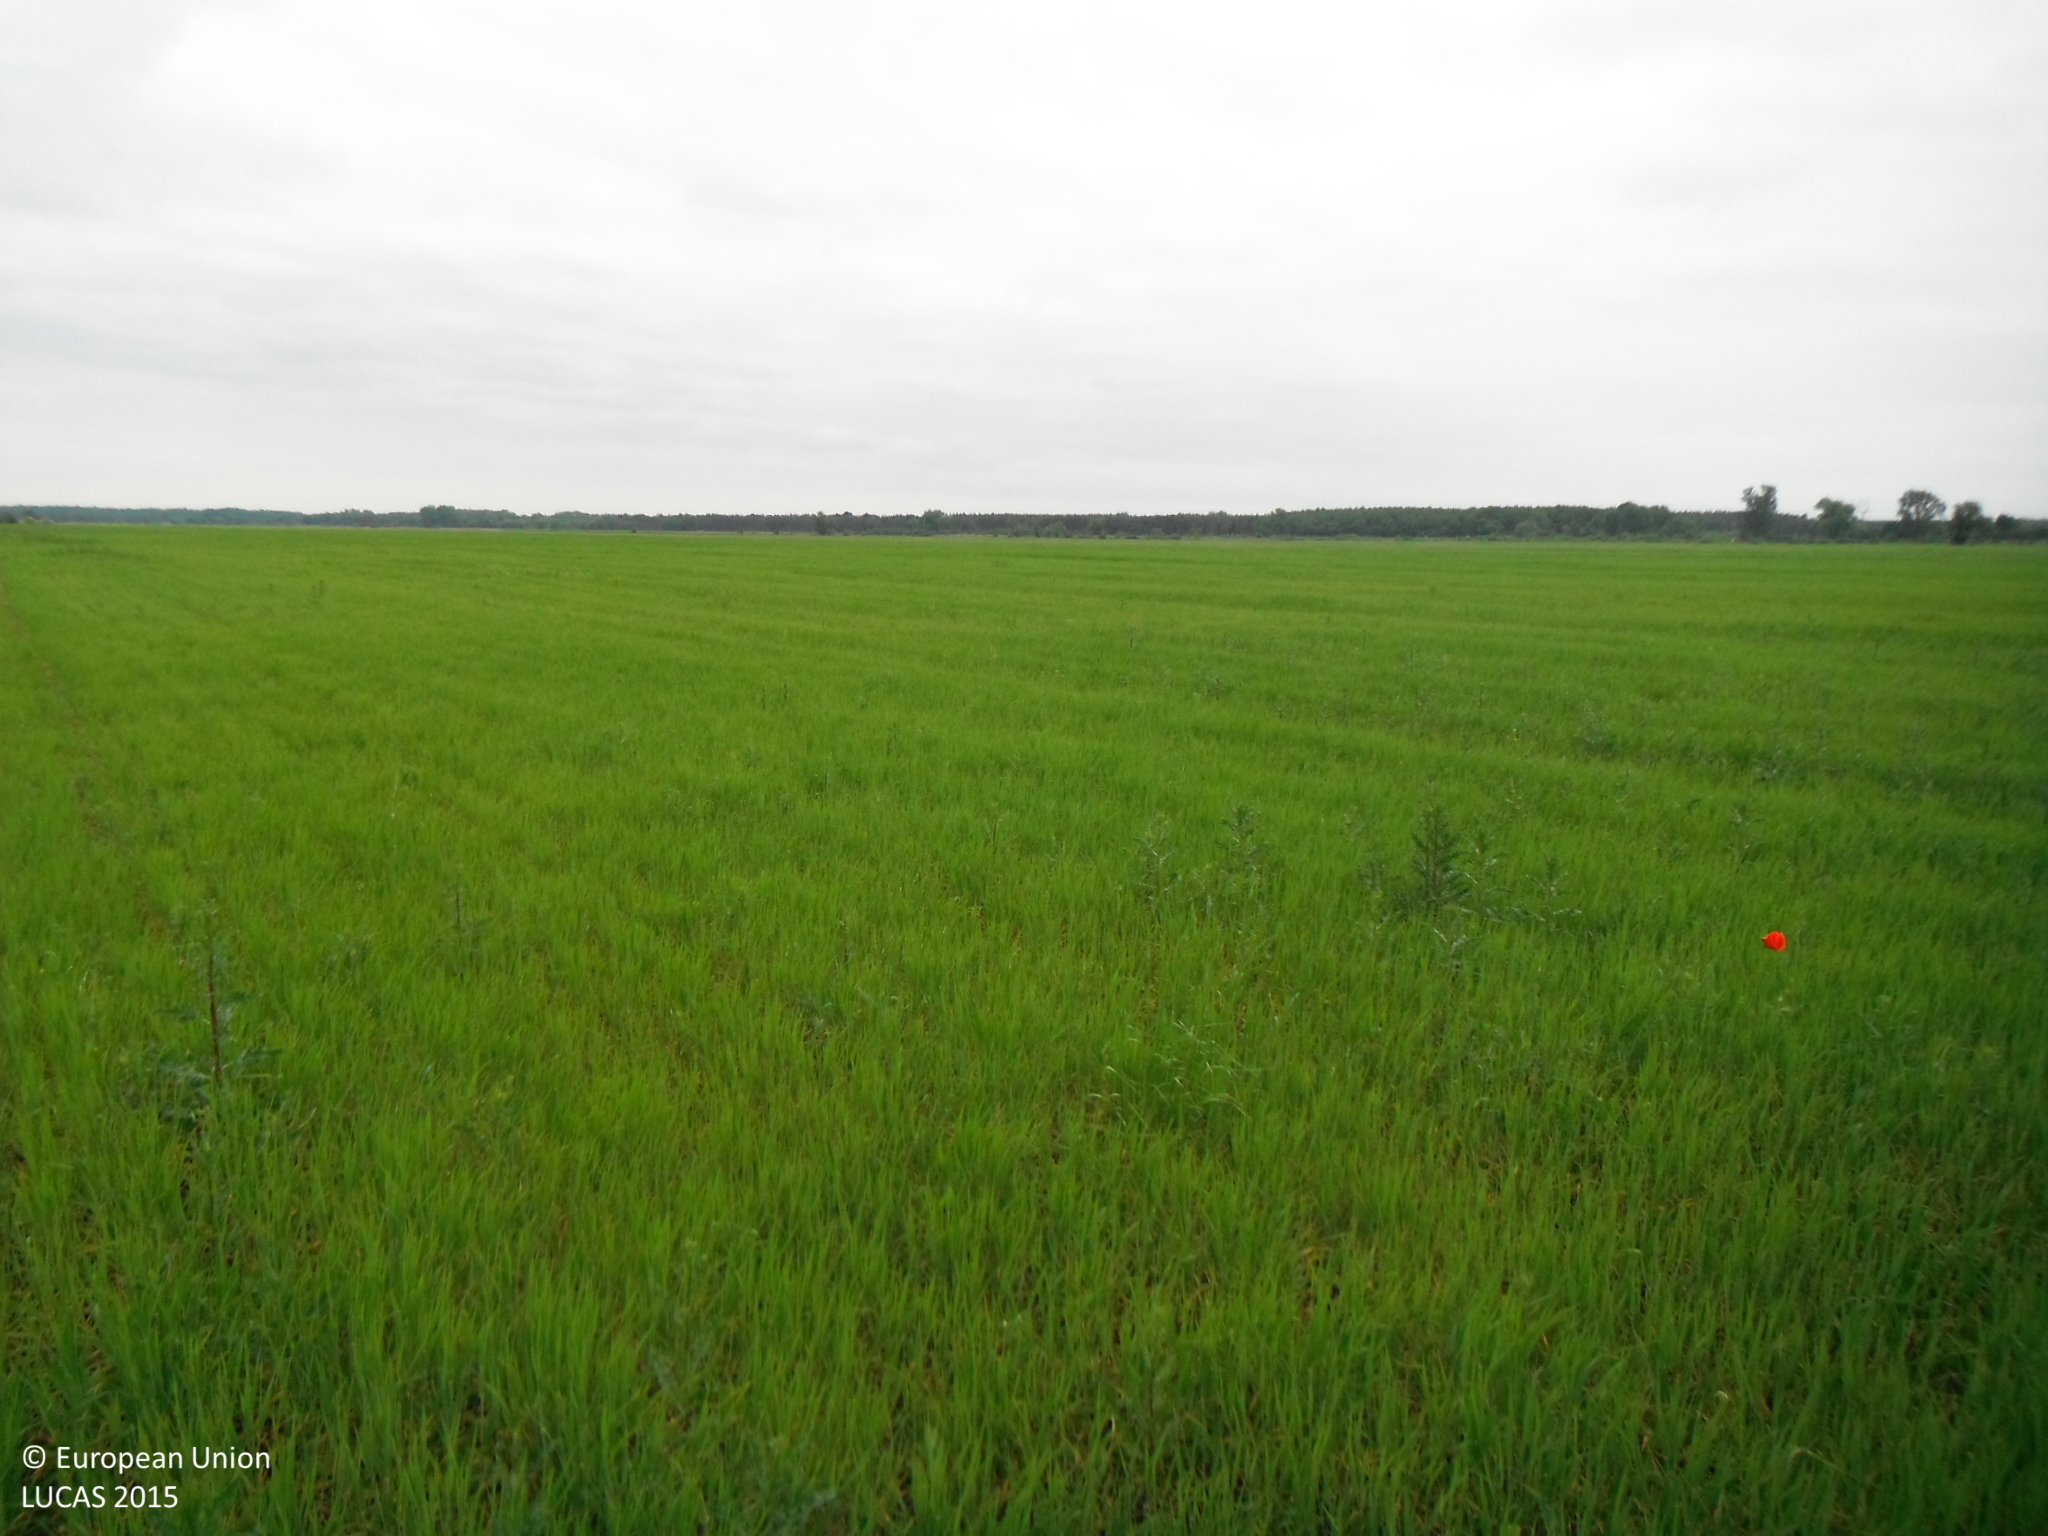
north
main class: Cropland
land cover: Barley
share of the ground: > 75 %
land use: Agriculture (excluding fallow land and kitchen gardens)
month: May
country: SK
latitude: 48.3485
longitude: 16.9297
